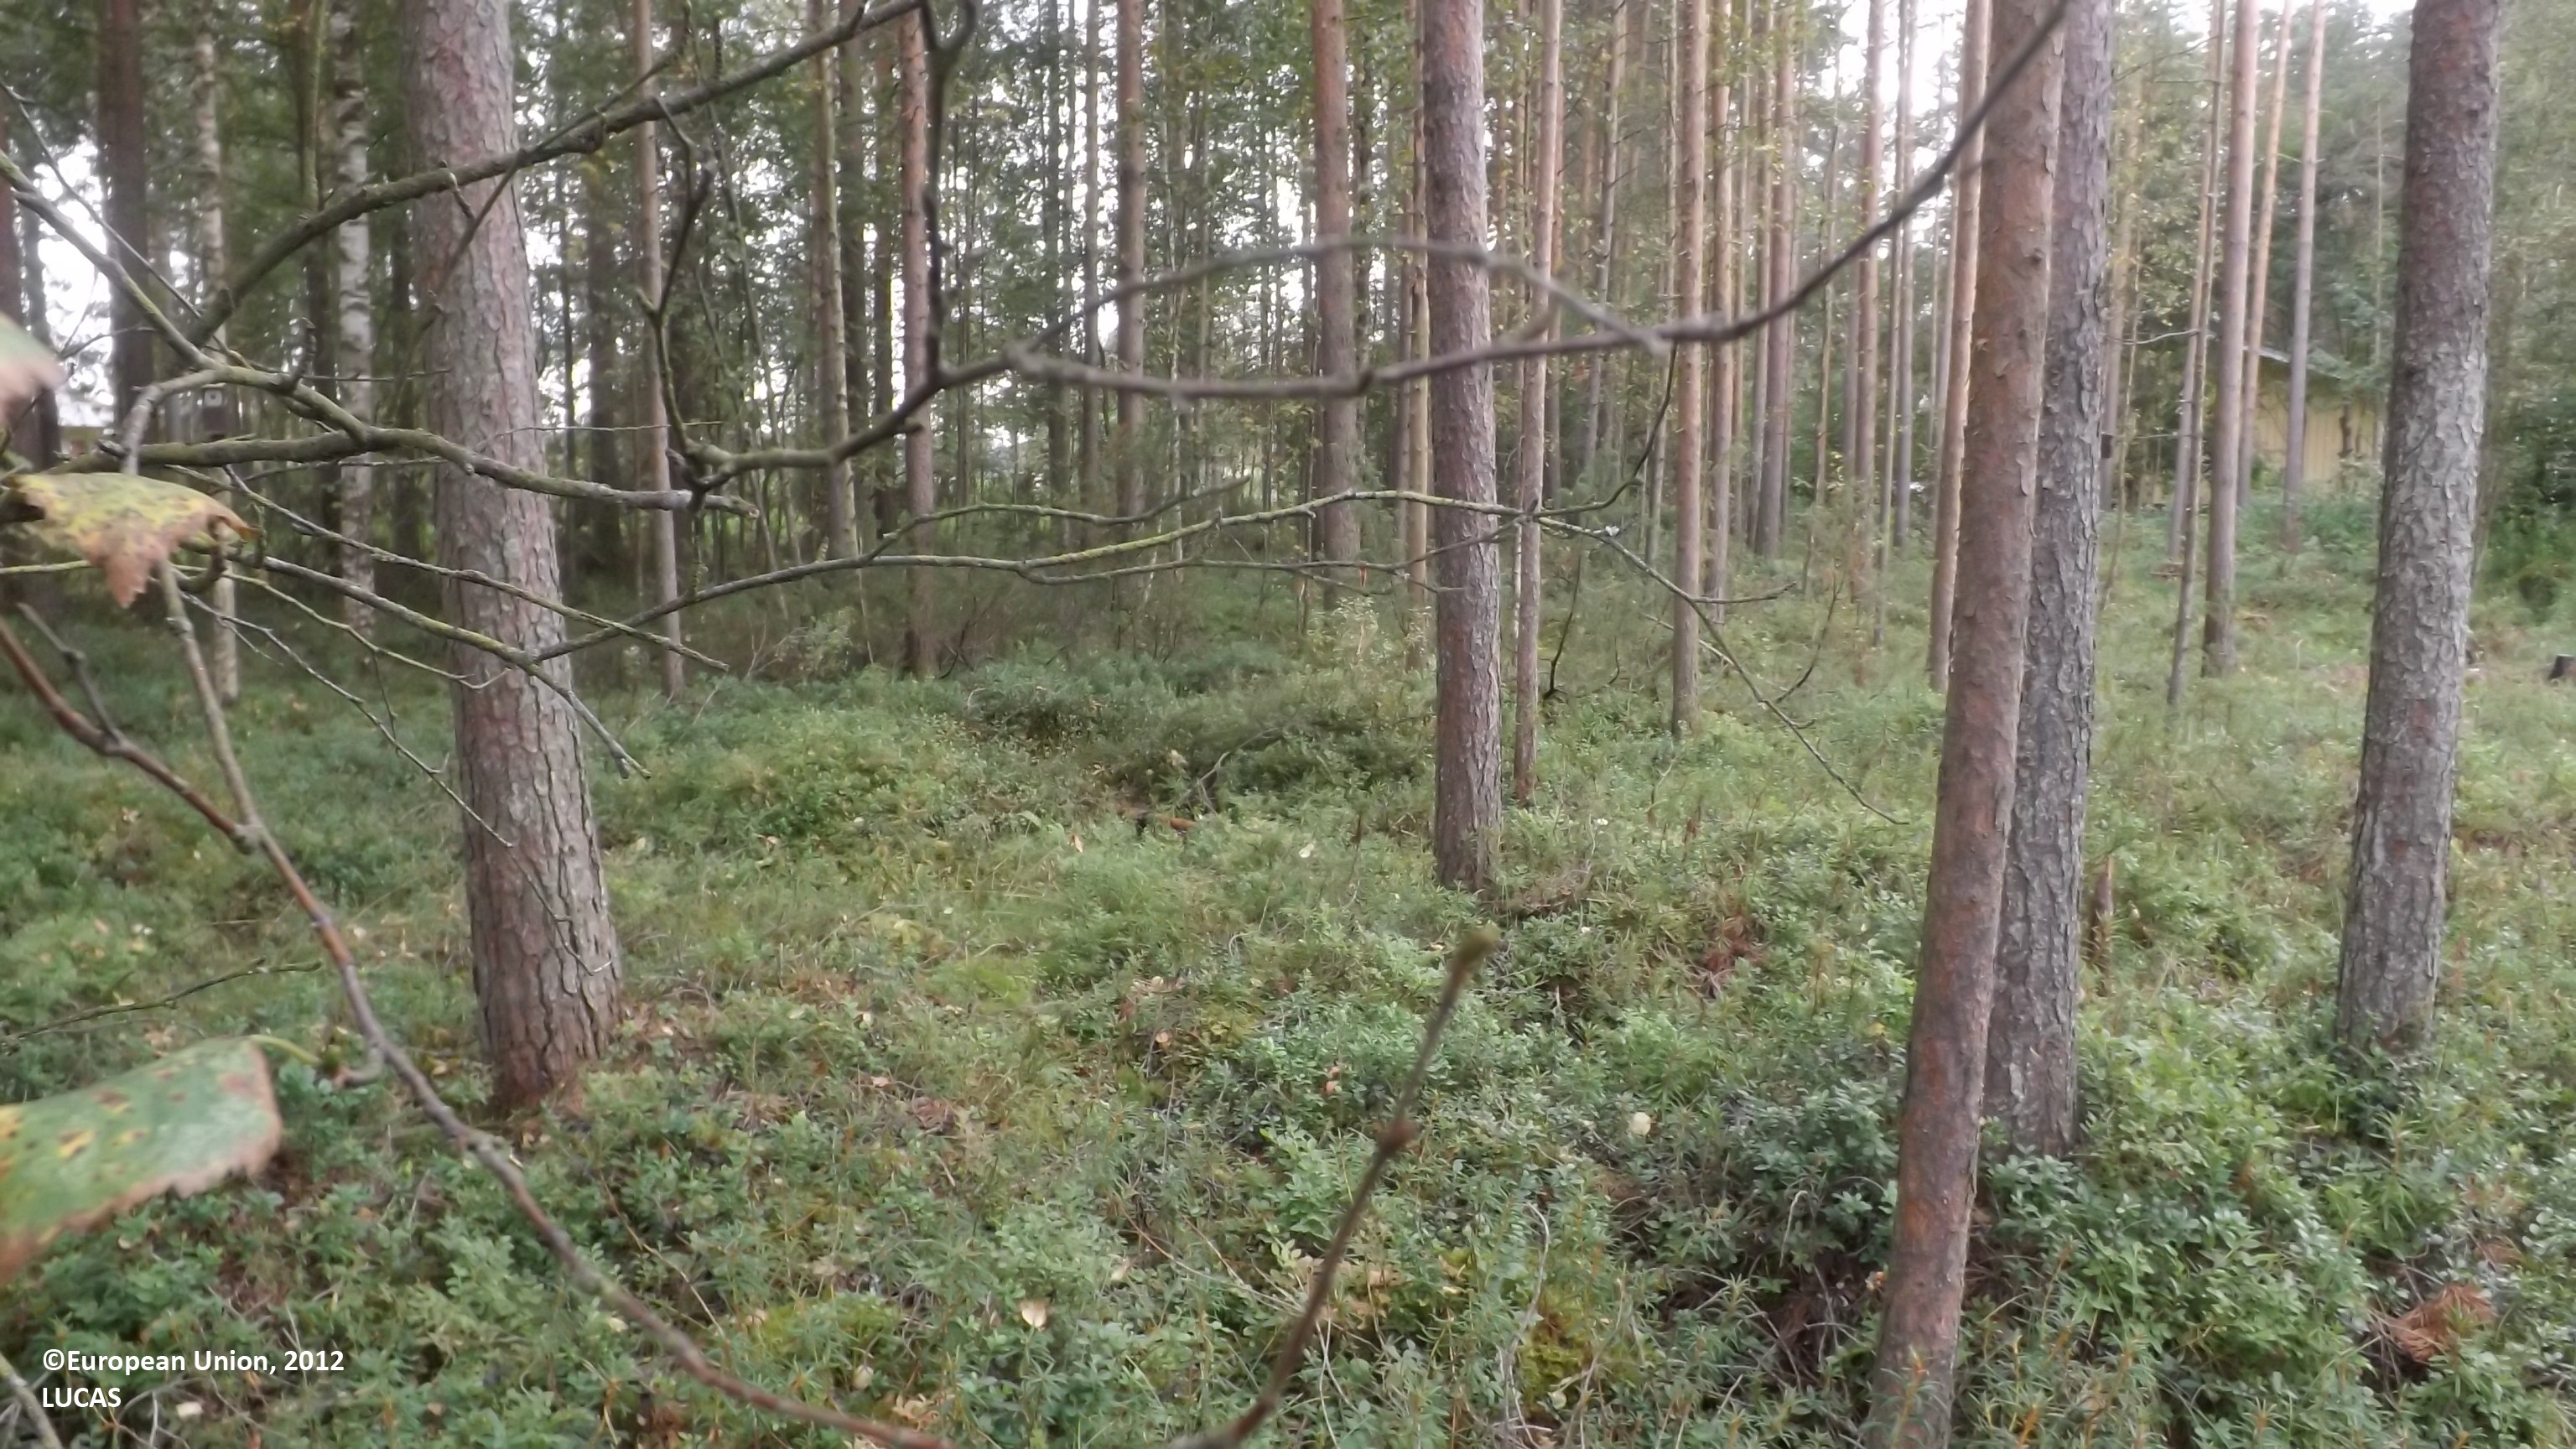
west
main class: Woodland
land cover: Pine dominated coniferous woodland
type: boreal forest
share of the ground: 50 - 75 %
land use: Forestry
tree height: > 5 m
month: August
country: FI
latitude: 63.8970
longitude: 23.8550
